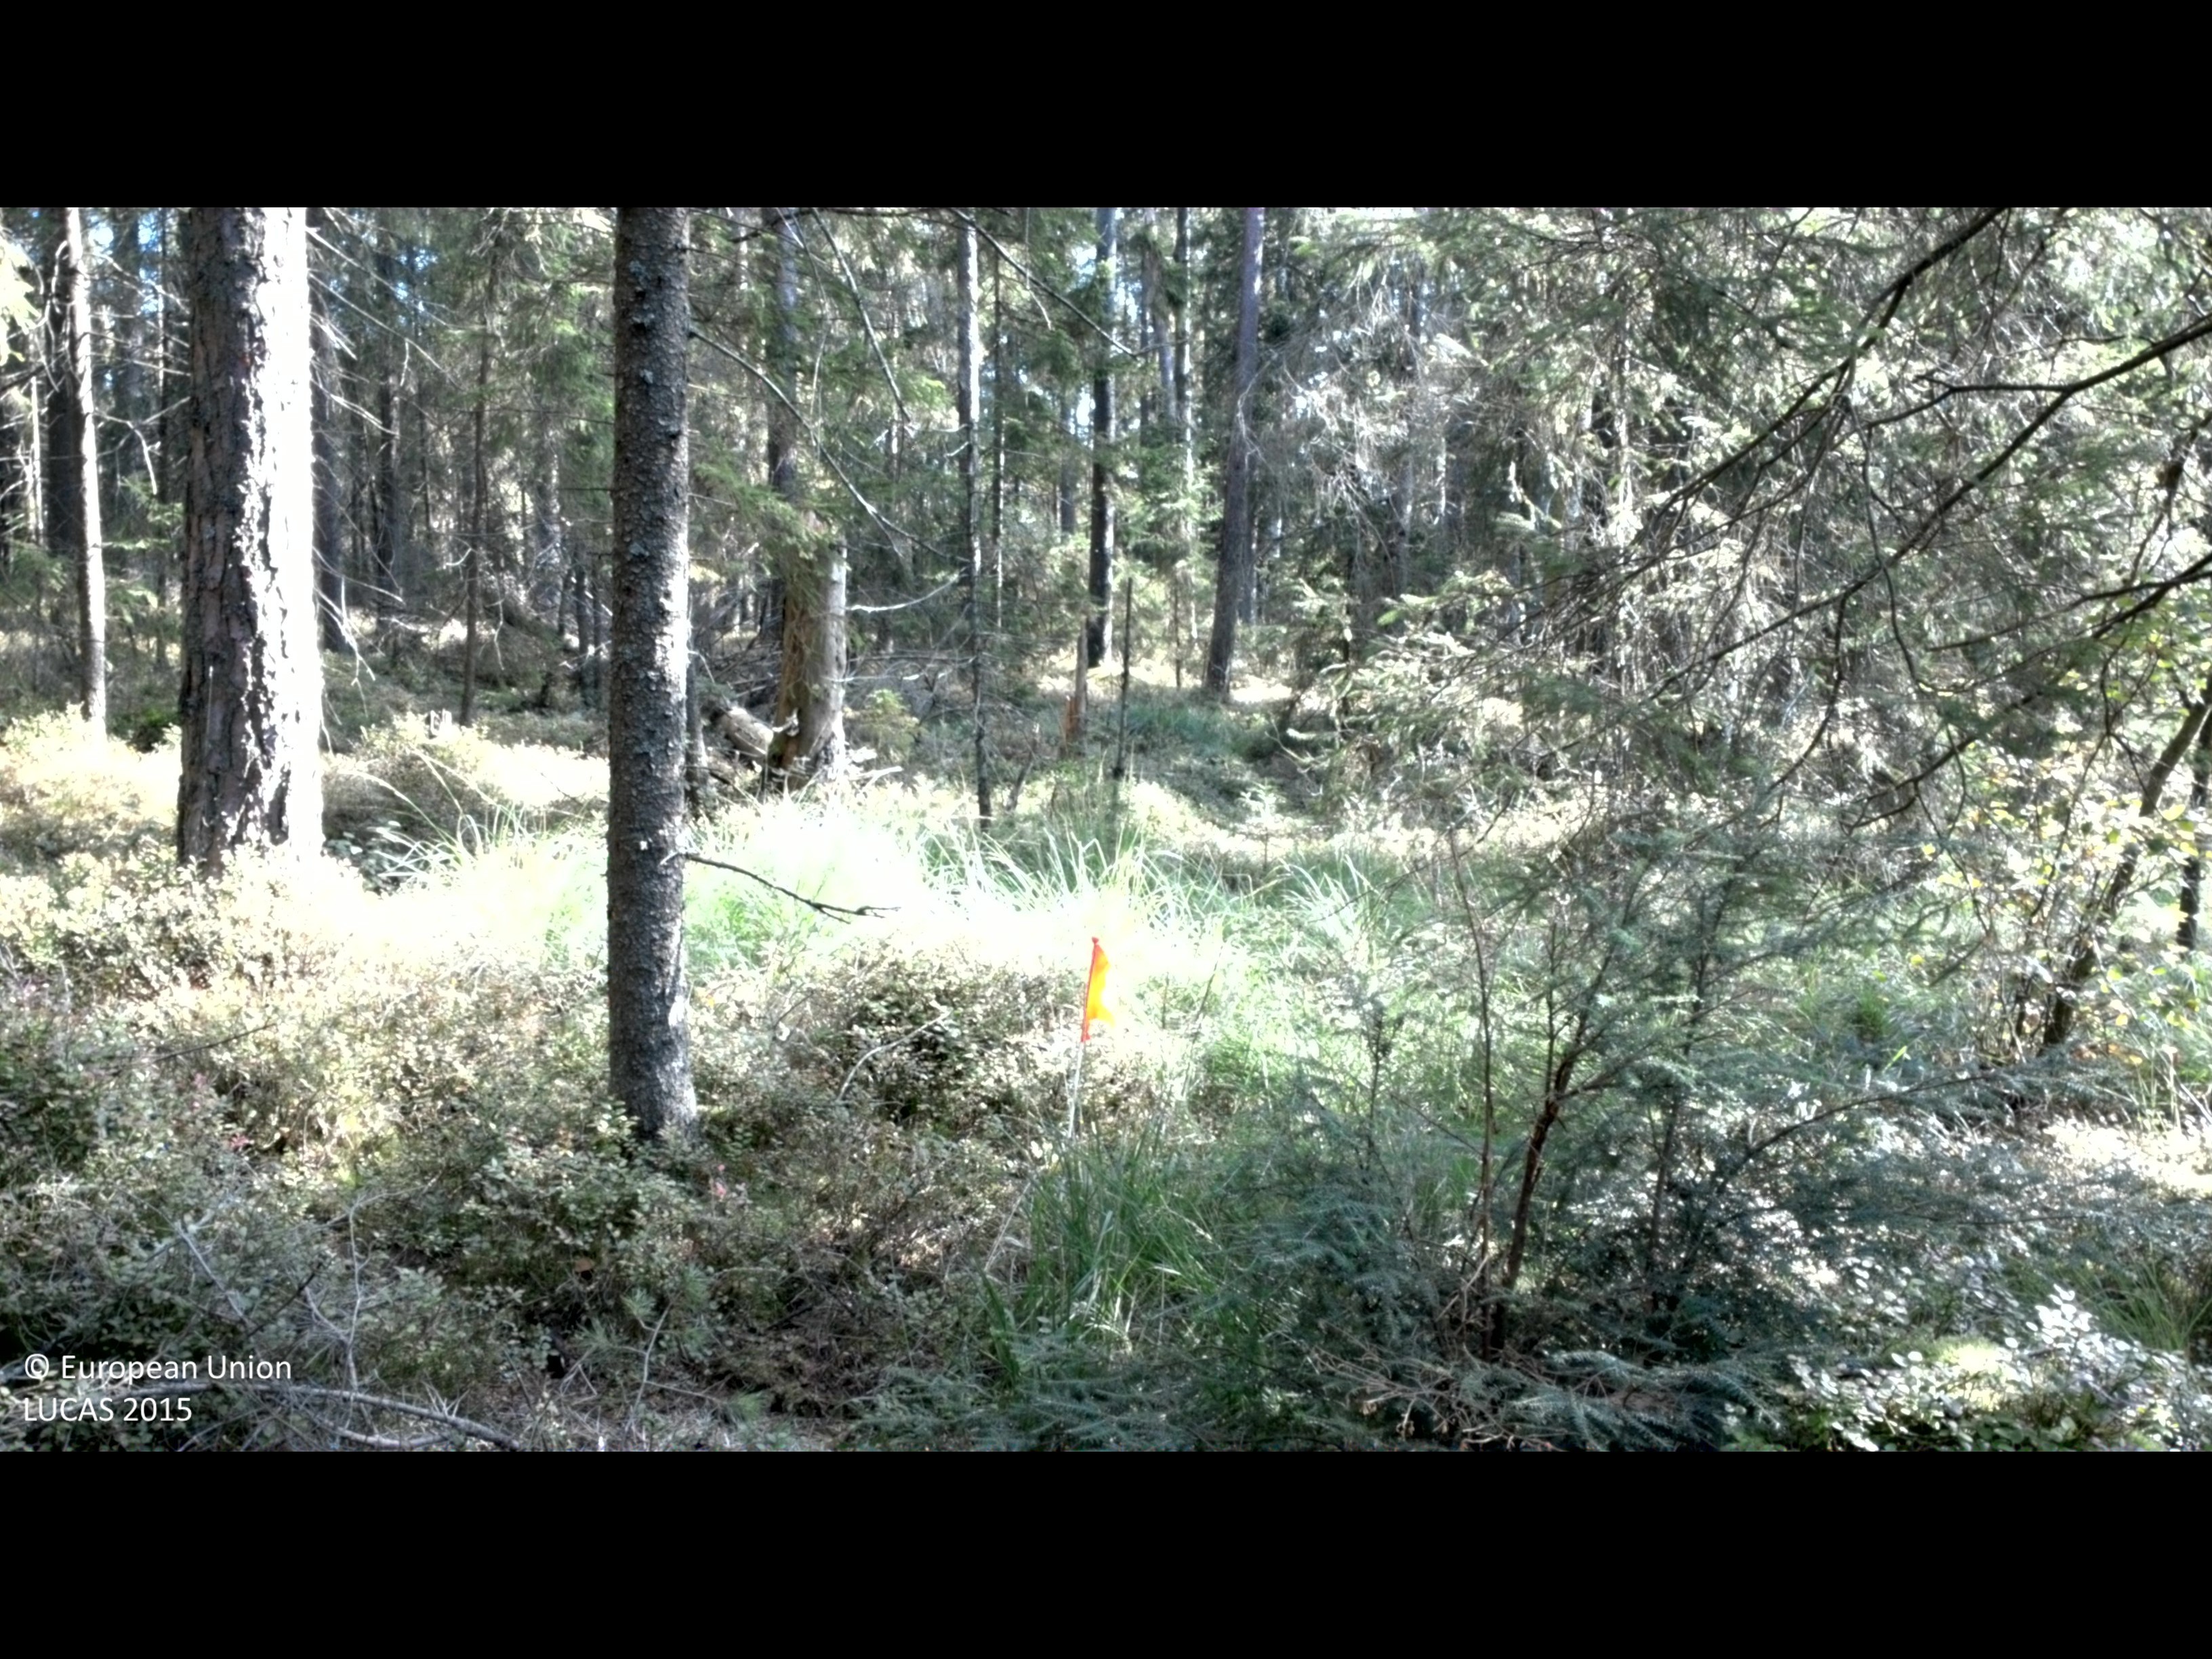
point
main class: Woodland
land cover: Spruce dominated coniferous woodland
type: boreal forest
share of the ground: 50 - 75 %
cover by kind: coniferous forest trees 65 %, shrubs 25 %, broadleaved forest trees 5 %, herbaceous plants 5 %
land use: Forestry
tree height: > 5 m
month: September
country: SE
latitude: 56.8147
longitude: 13.1582
